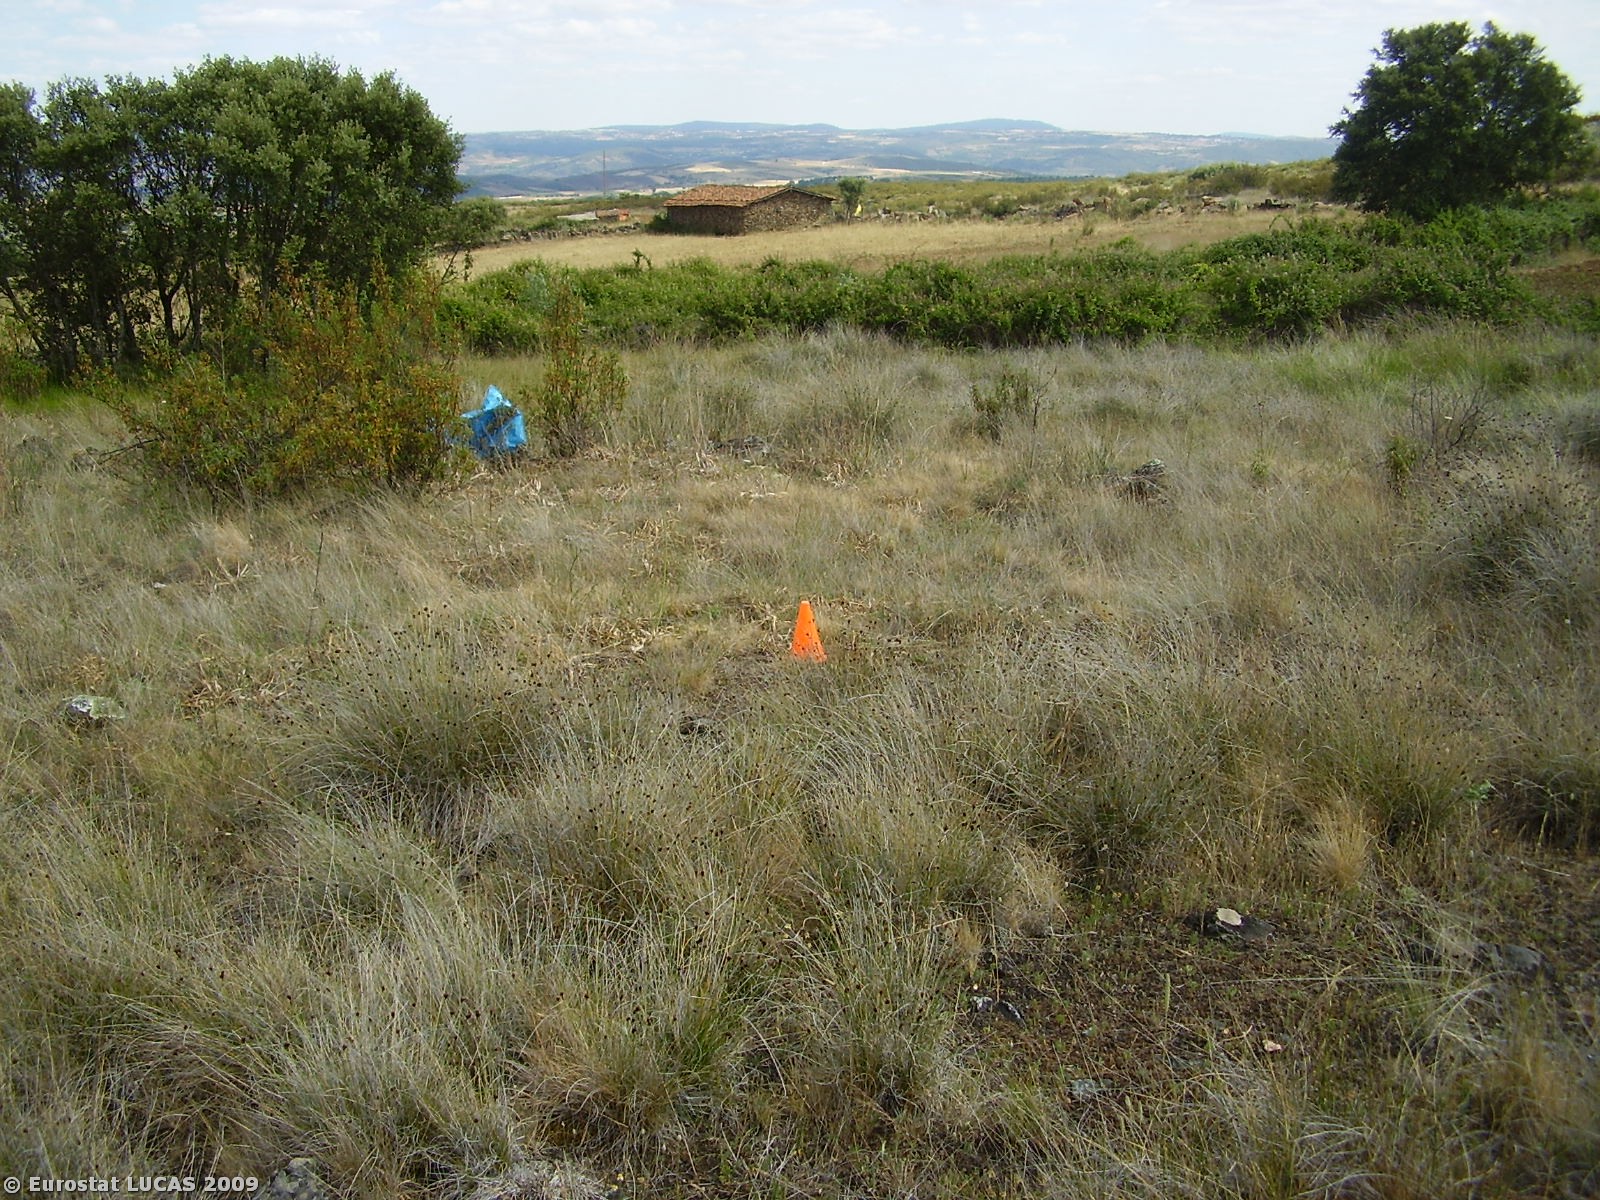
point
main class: Grassland
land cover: Spontaneously vegetated surfaces
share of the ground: > 75 %
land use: Fallow land
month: June
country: PT
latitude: 41.5013
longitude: -6.7729
